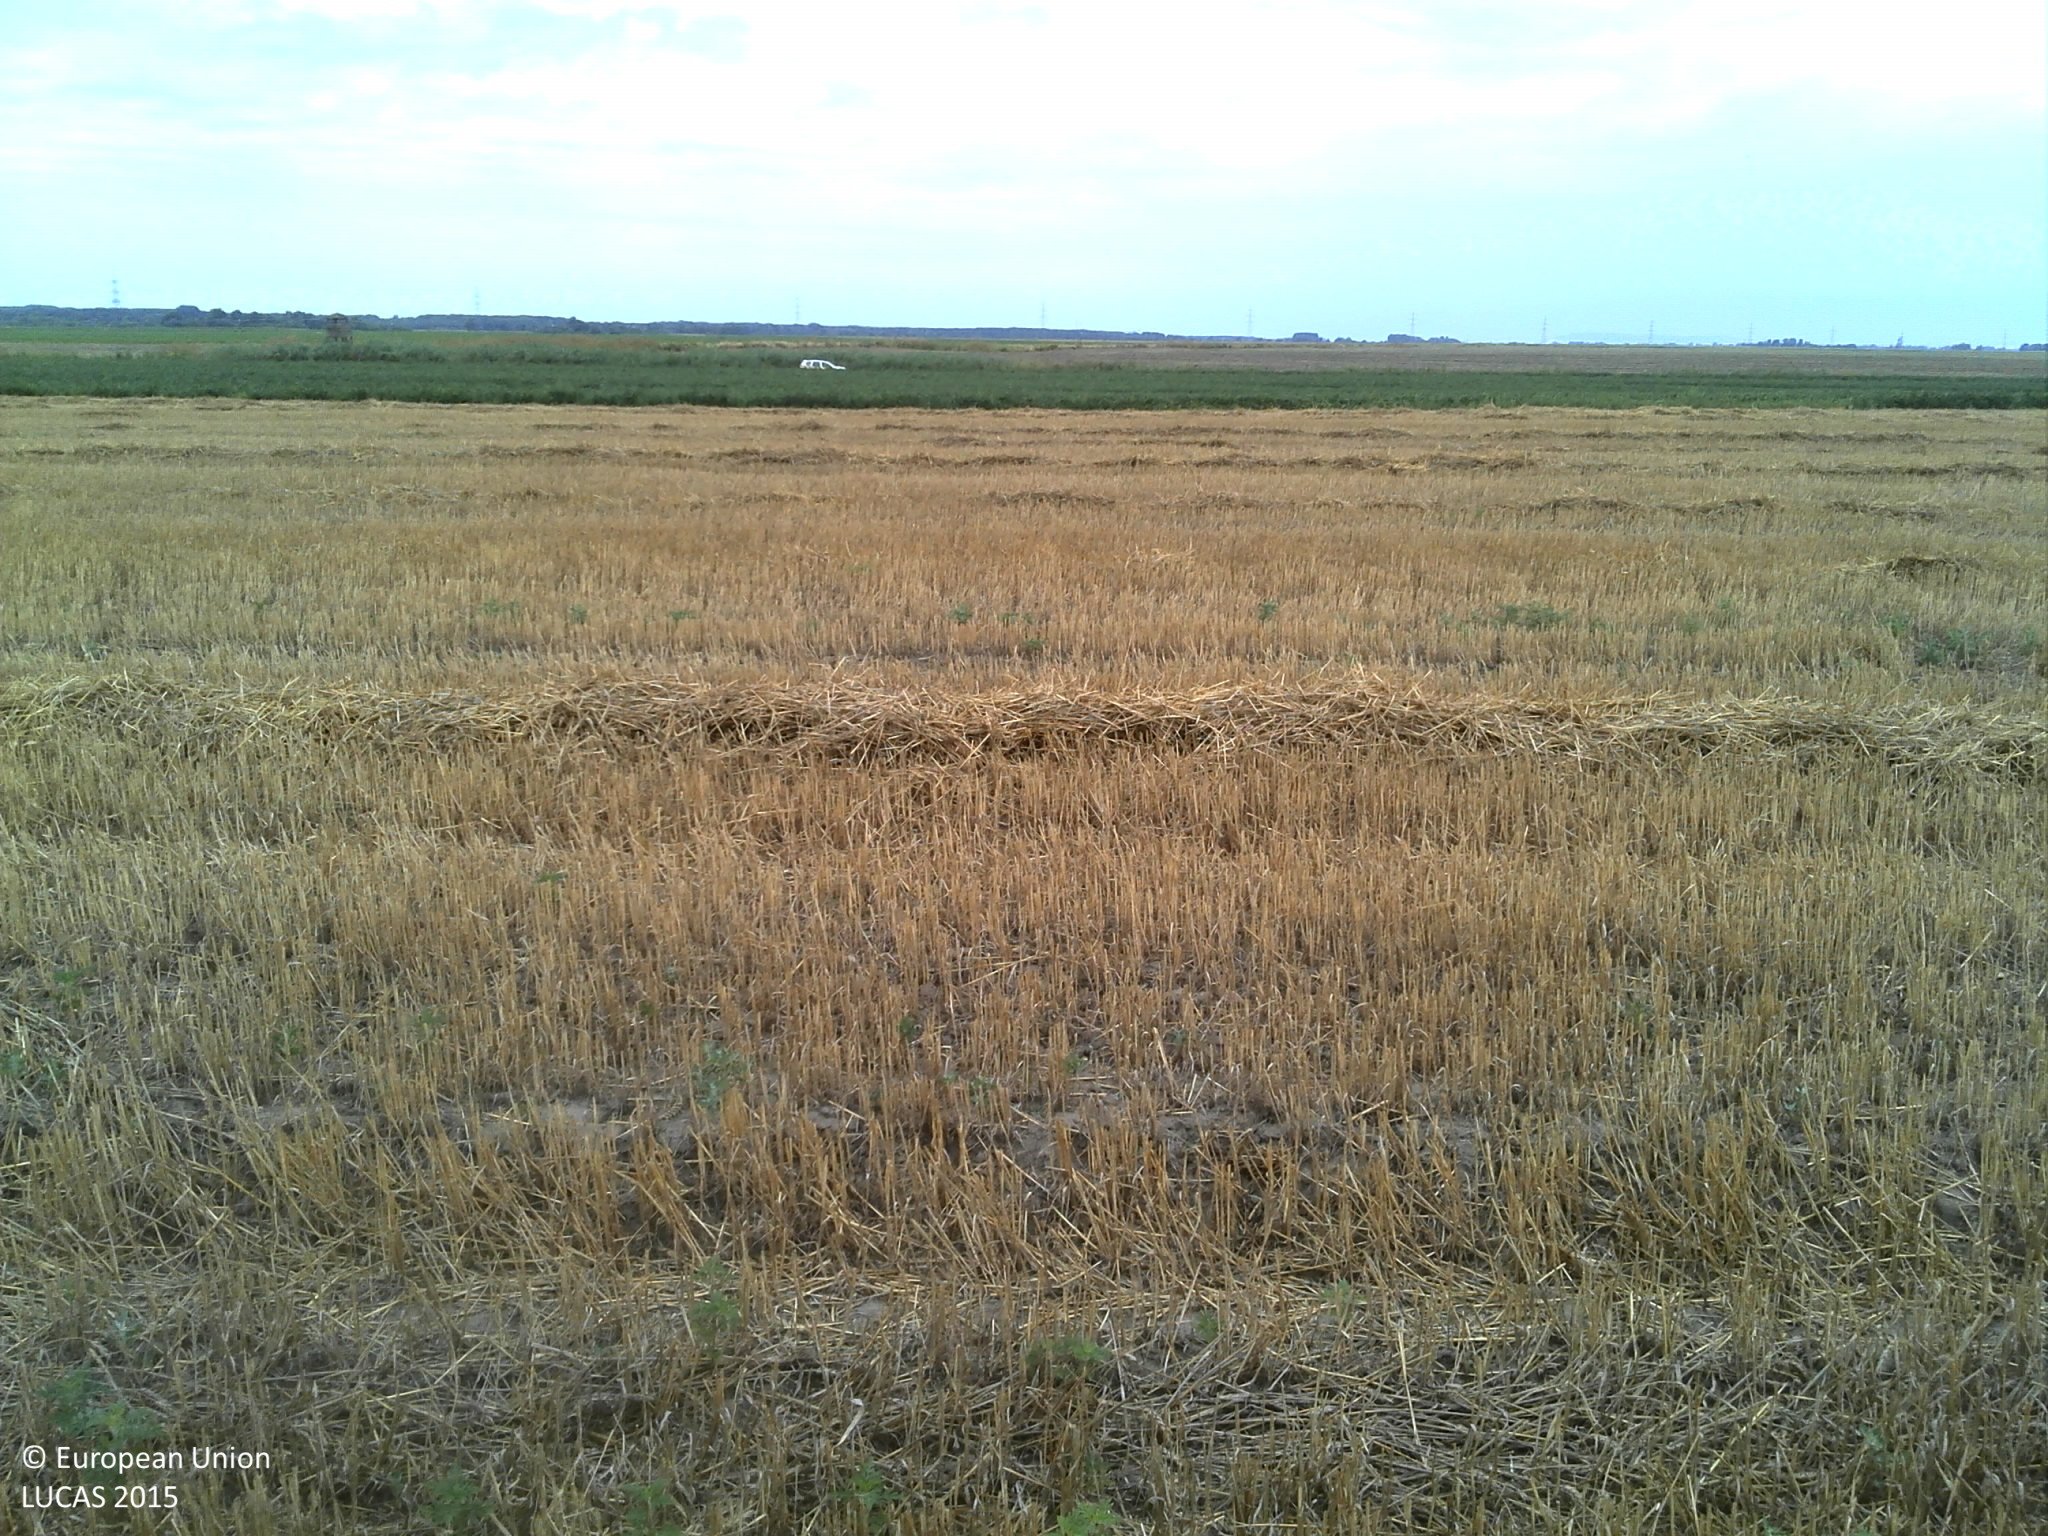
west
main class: Cropland
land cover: Common wheat
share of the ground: > 75 %
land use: Agriculture (excluding fallow land and kitchen gardens)
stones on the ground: < 10 %
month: July
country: HR
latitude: 45.6607
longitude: 18.5937
